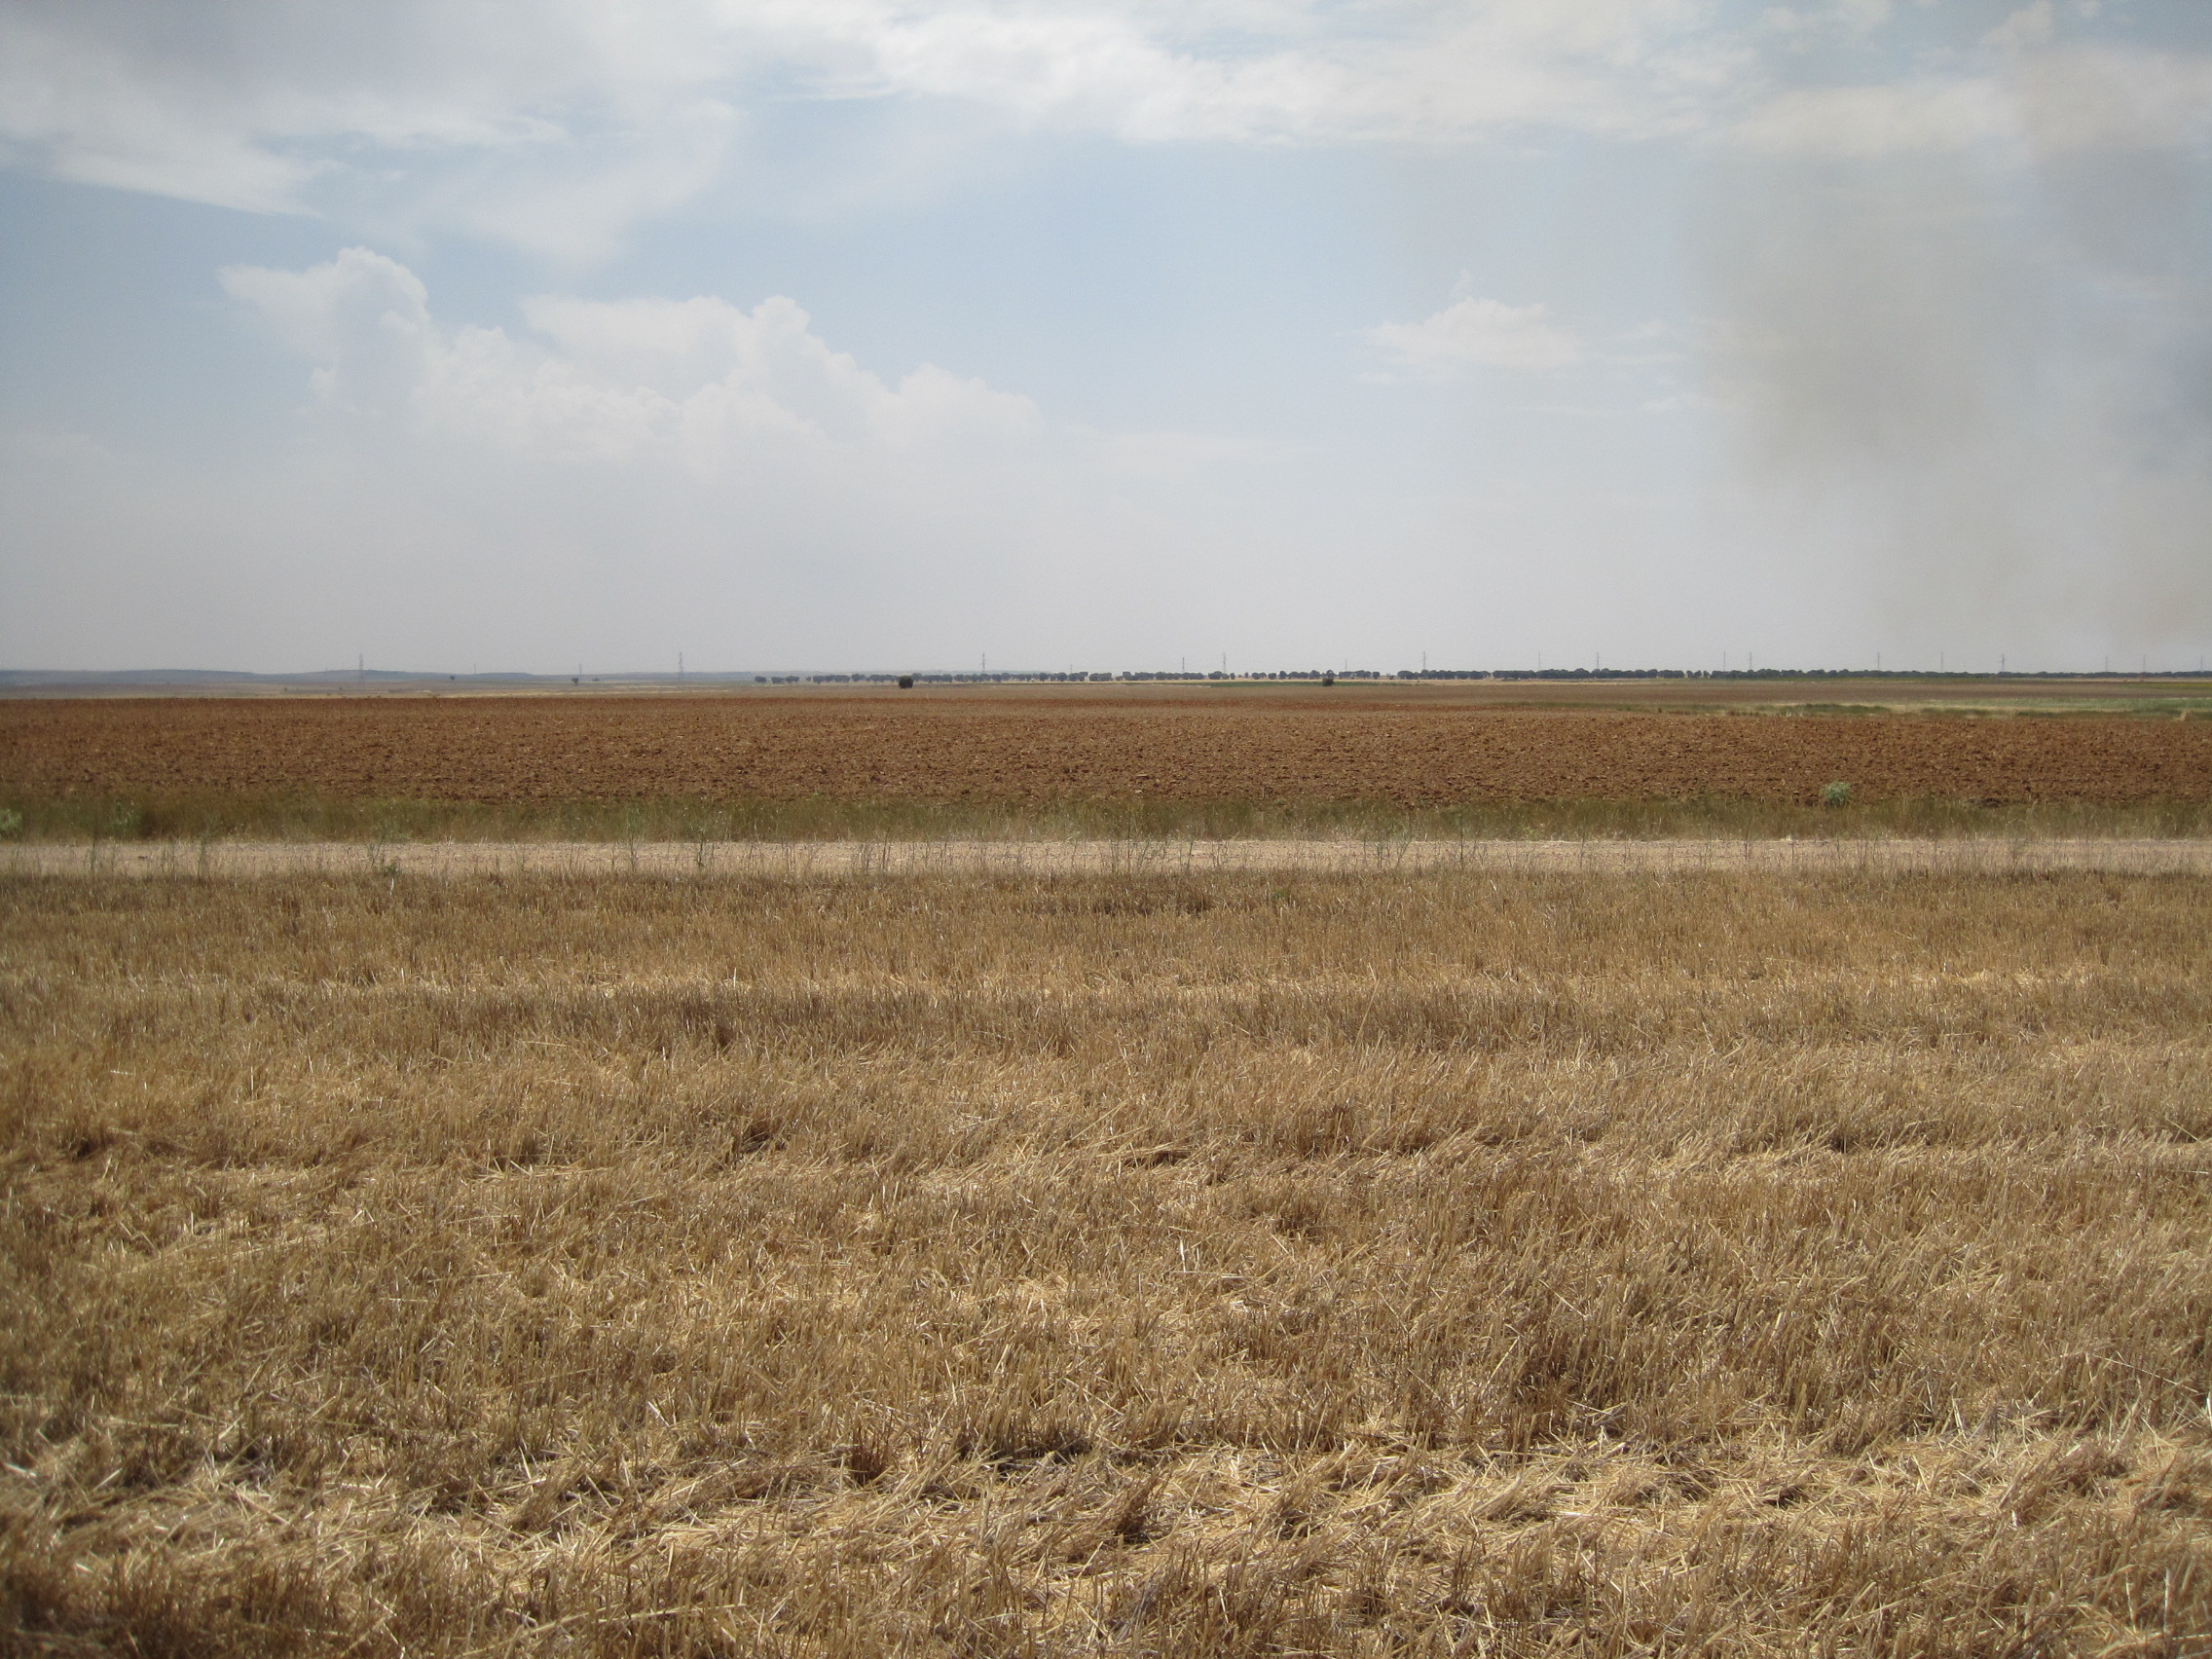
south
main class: Cropland
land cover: Common wheat
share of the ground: < 10 %
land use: Agriculture (excluding fallow land and kitchen gardens)
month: July
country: ES
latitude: 41.7330
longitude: -5.5835
